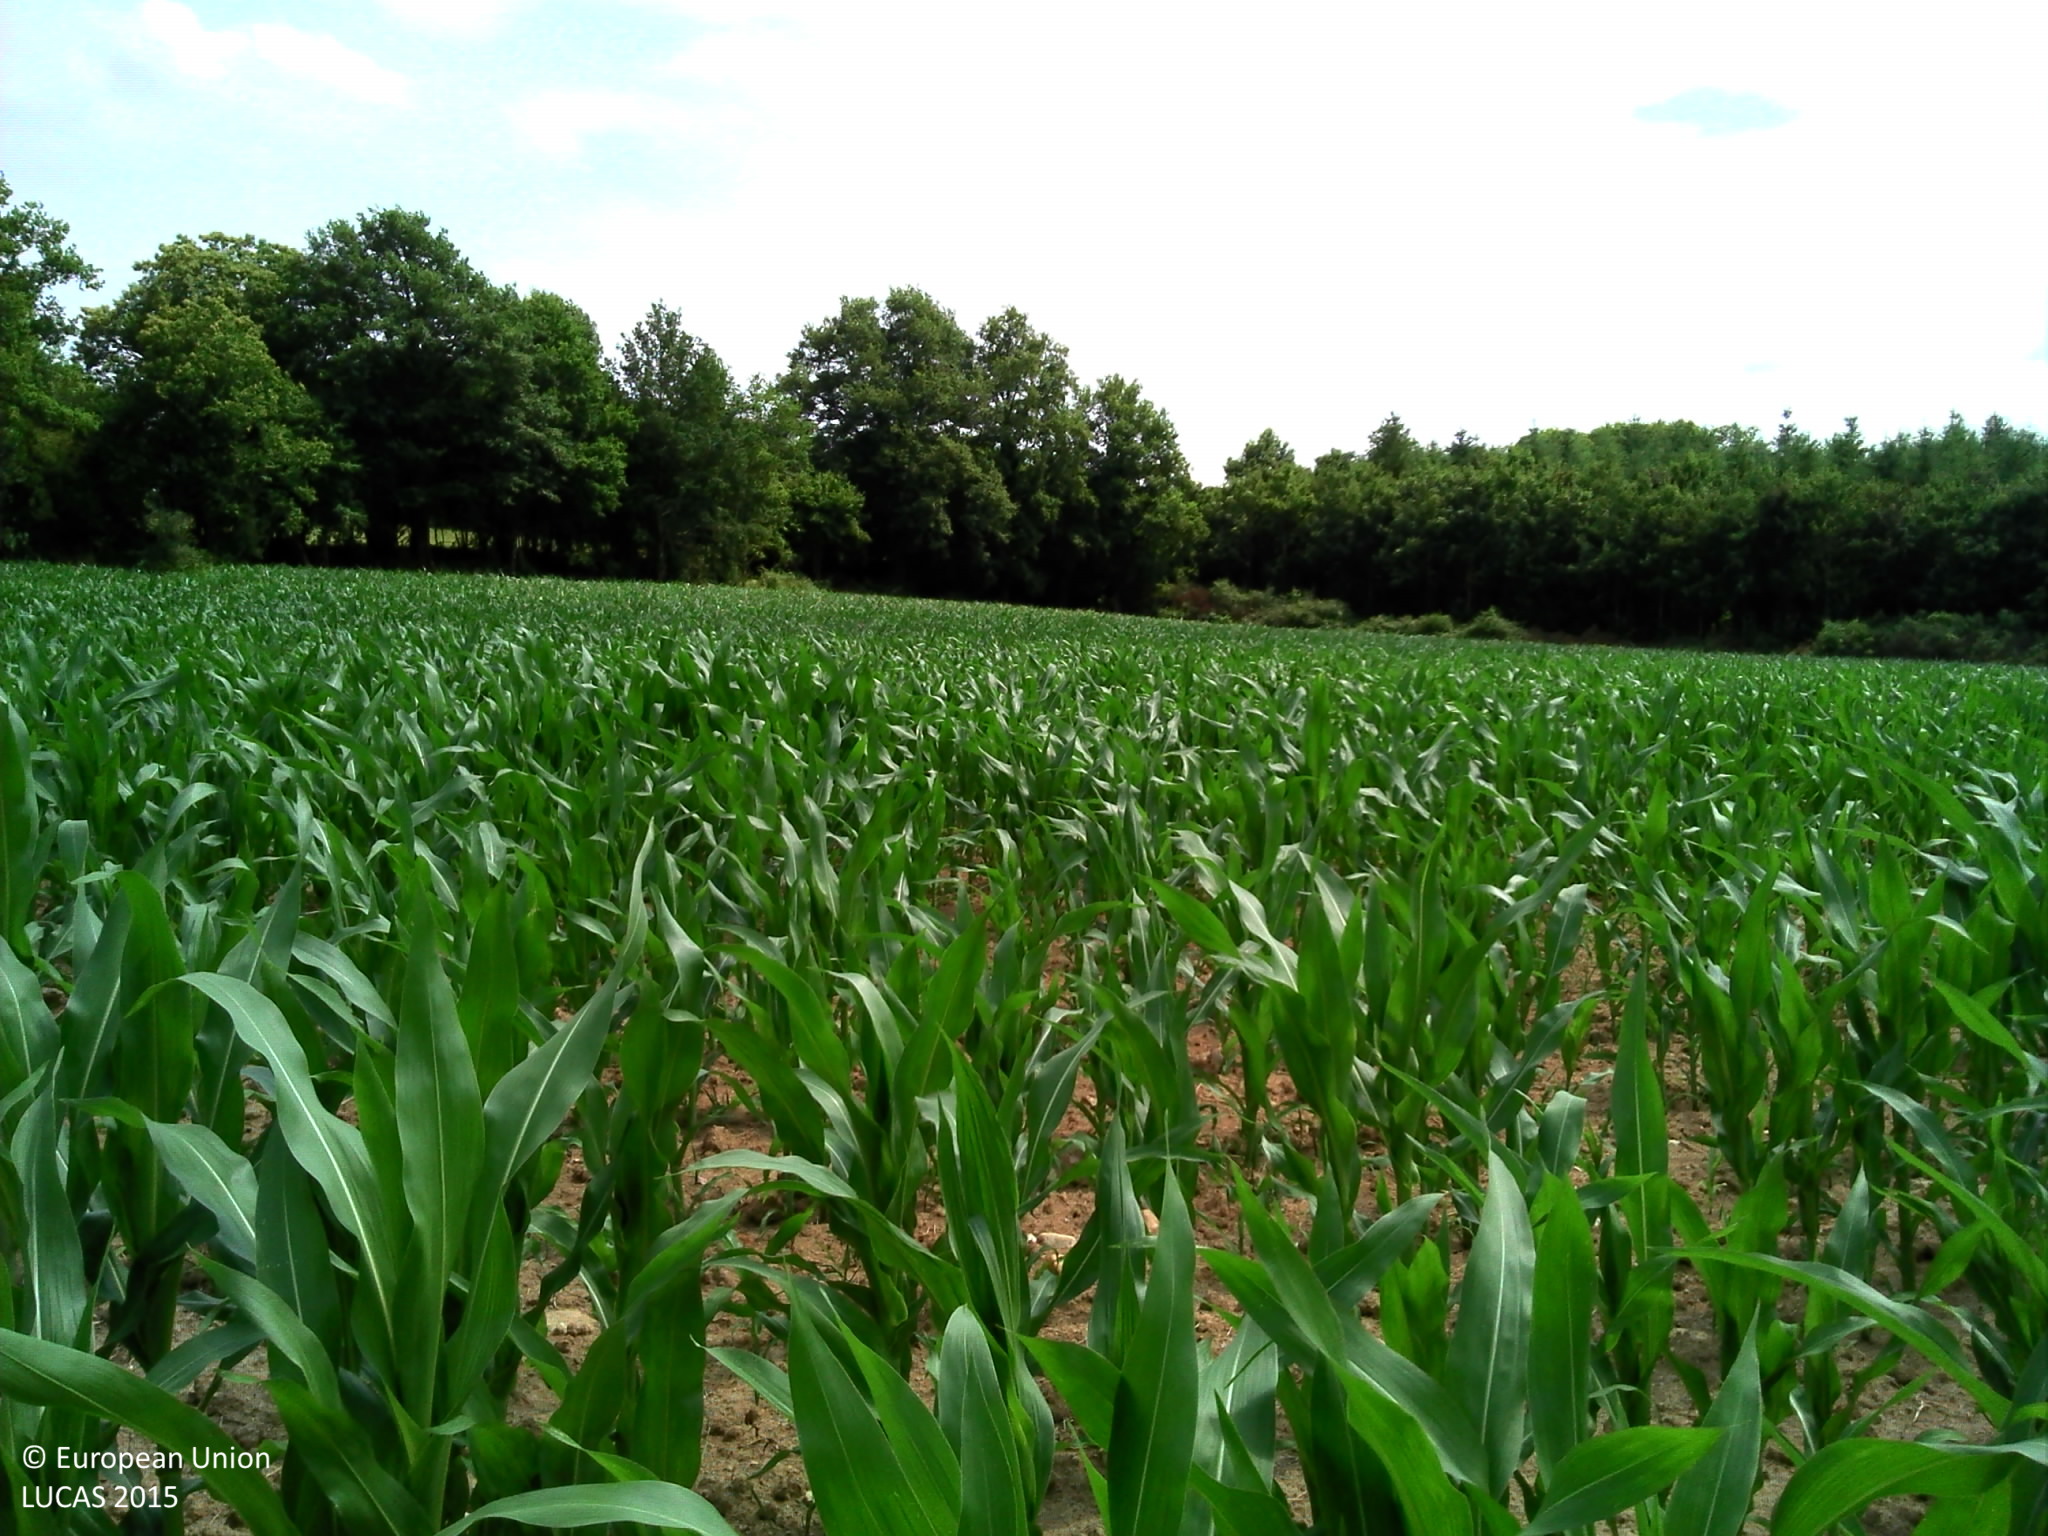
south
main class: Cropland
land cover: Maize
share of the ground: > 75 %
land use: Agriculture (excluding fallow land and kitchen gardens)
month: July
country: FR
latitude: 45.7252
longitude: 0.6717
